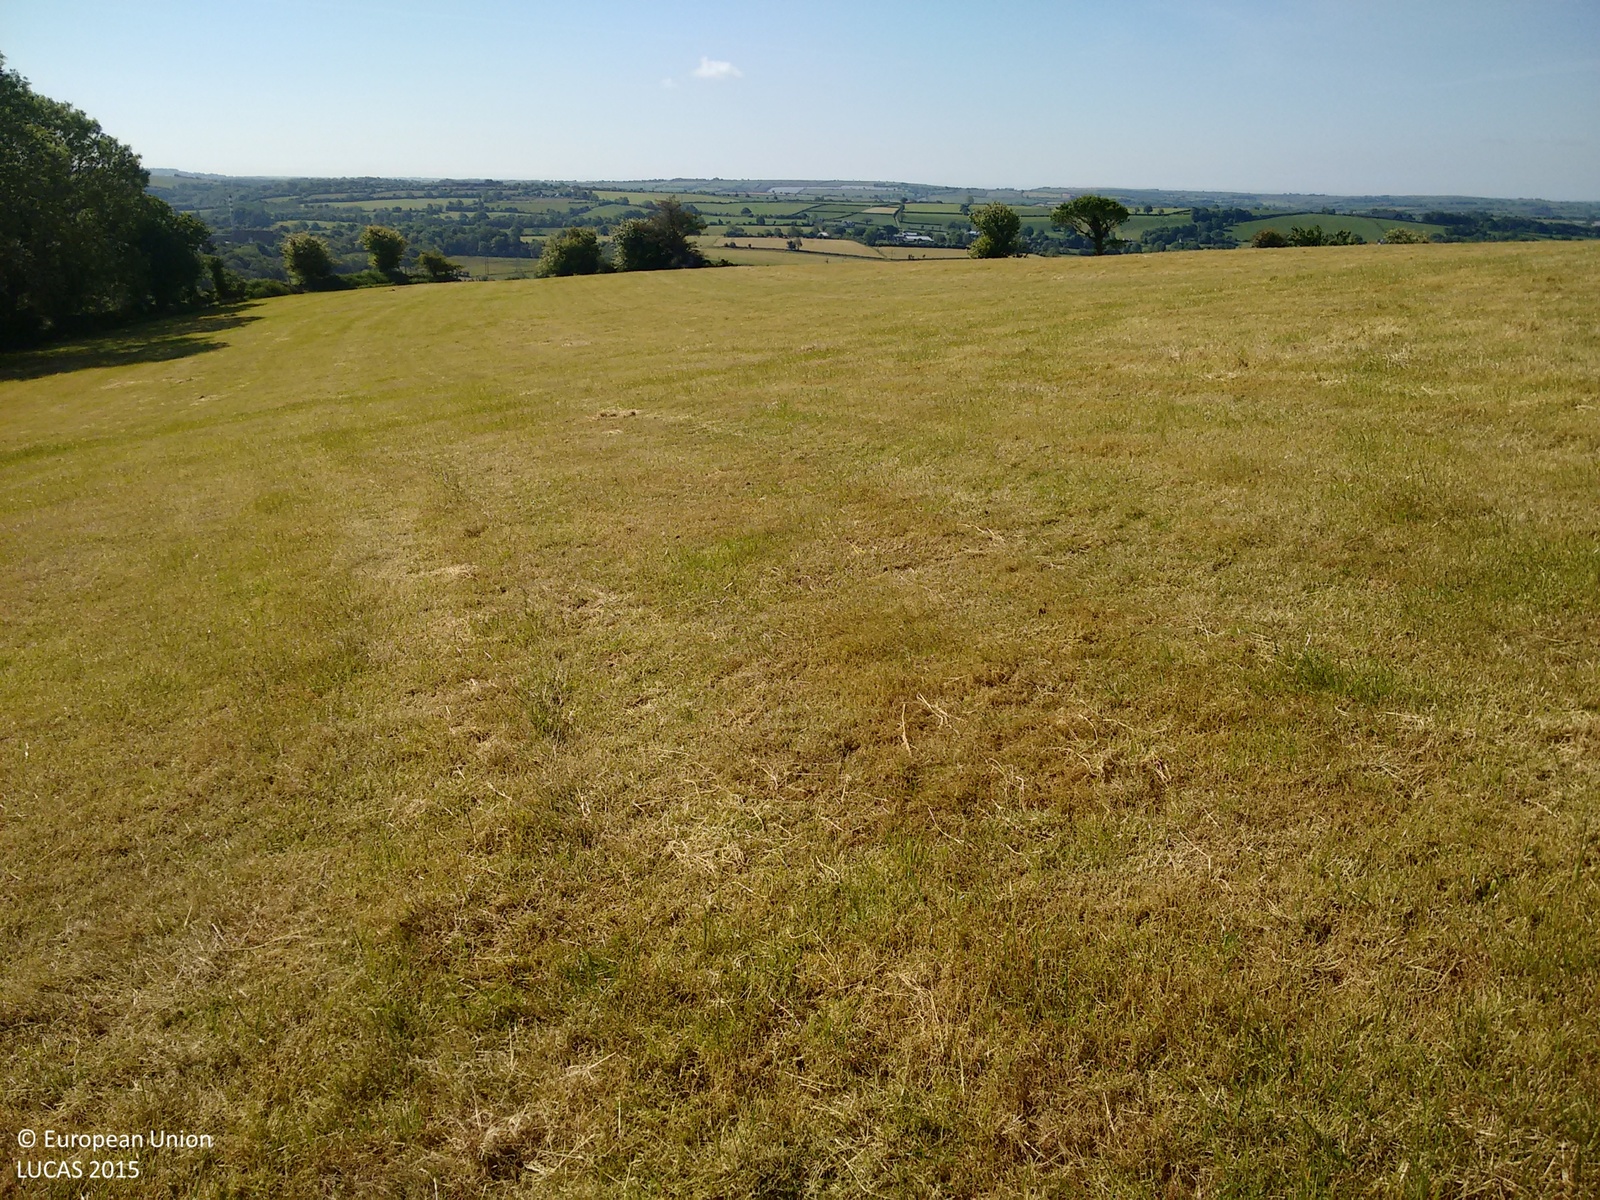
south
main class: Grassland
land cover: Grassland without tree/shrub cover
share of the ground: > 75 %
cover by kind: herbaceous plants 100 %
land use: Agriculture (excluding fallow land and kitchen gardens)
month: June
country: IE
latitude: 51.7929
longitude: -8.7171
